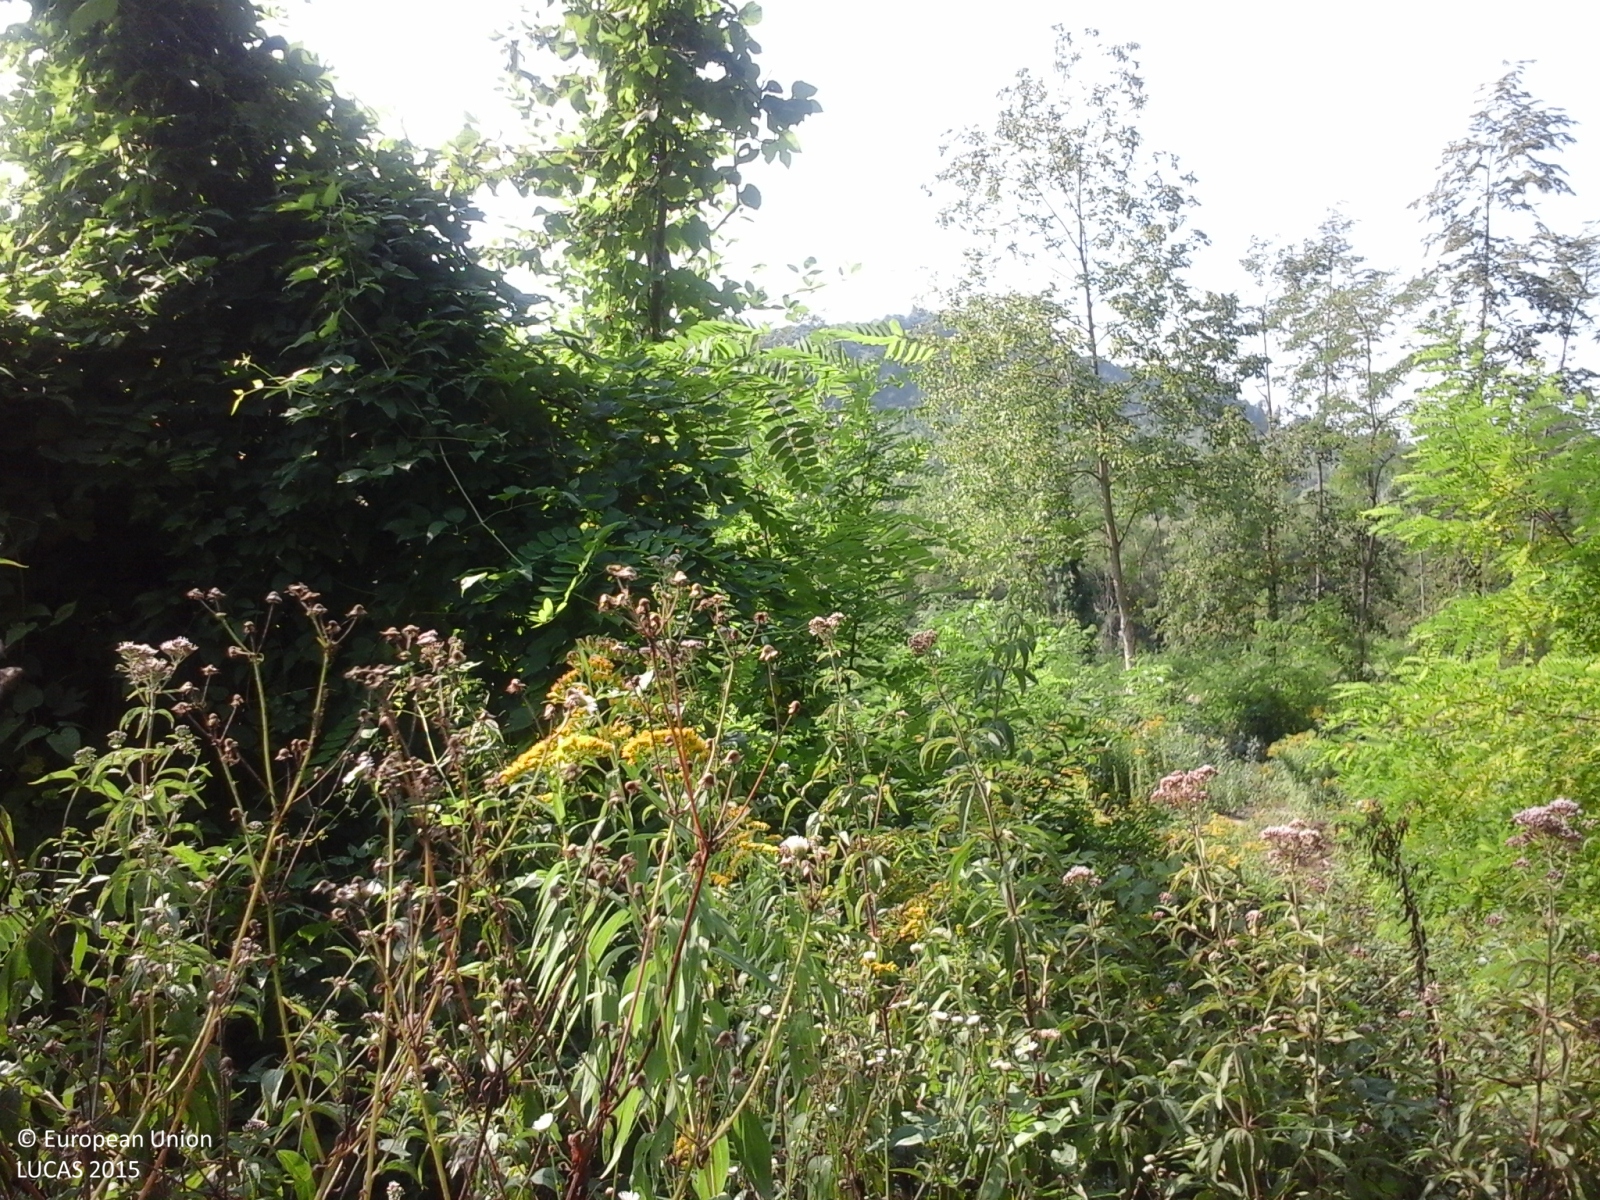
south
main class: Woodland
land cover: Broadleaved woodland
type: floodplain forest
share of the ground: > 75 %
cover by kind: broadleaved forest trees 95 %, herbaceous plants 5 %
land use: Semi-natural and natural areas not in use
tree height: > 5 m
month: August
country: IT
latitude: 44.5677
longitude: 8.1026
